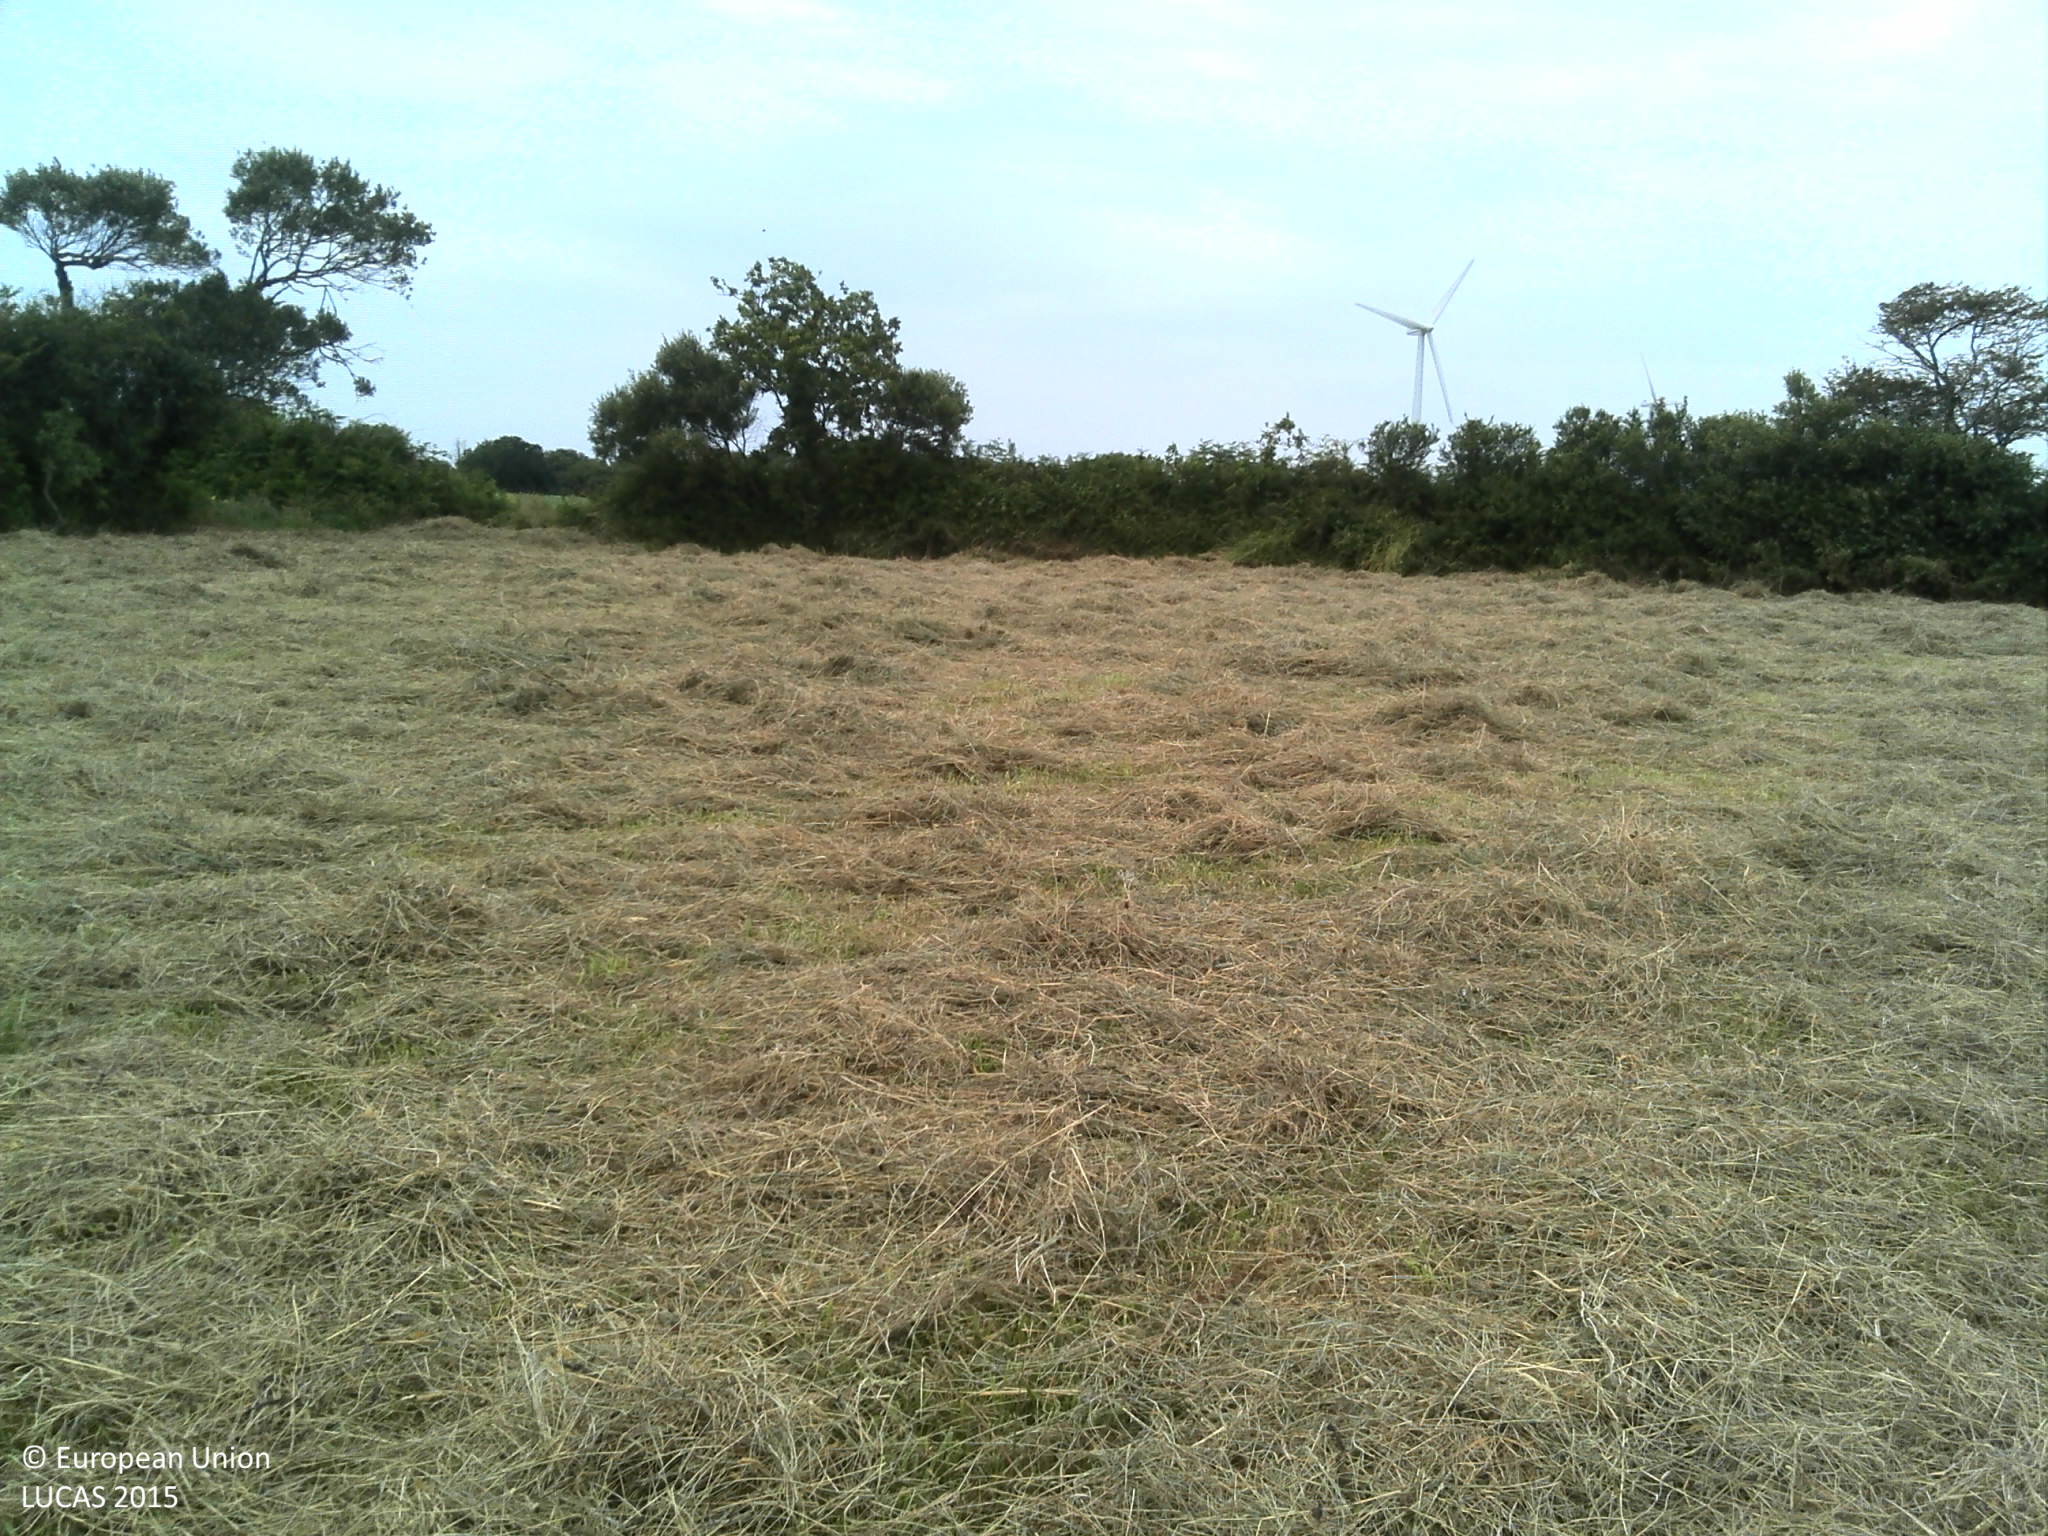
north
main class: Grassland
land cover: Grassland without tree/shrub cover
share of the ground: > 75 %
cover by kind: herbaceous plants 100 %
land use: Agriculture (excluding fallow land and kitchen gardens)
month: July
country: FR
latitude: 48.3938
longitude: -4.7578
